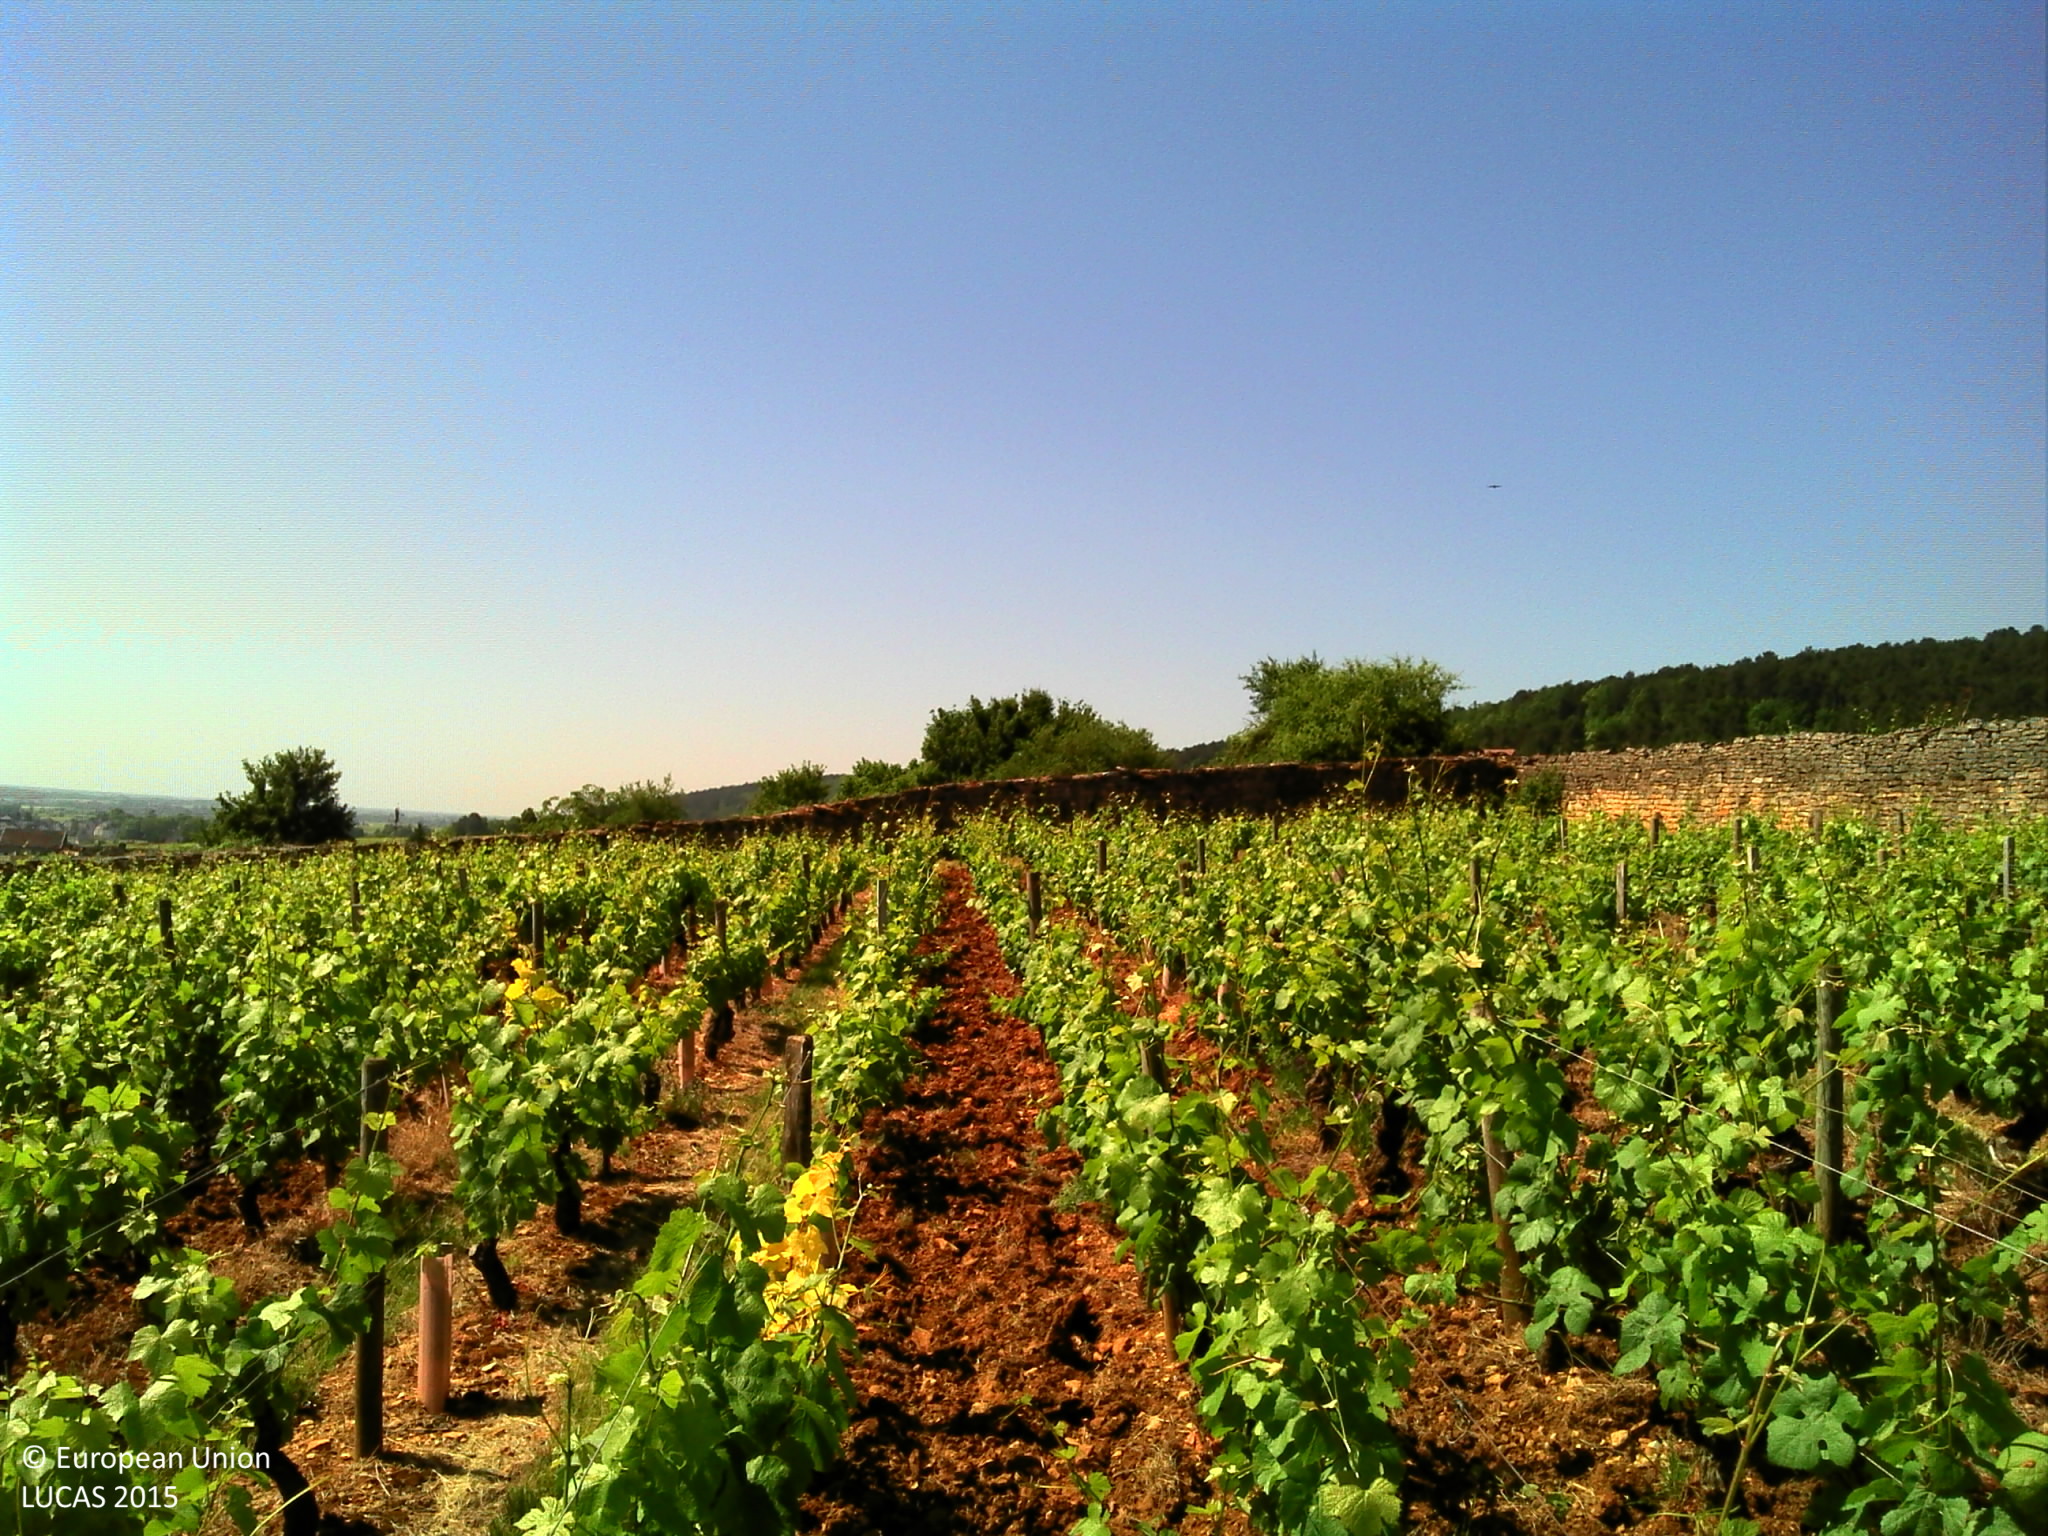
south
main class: Cropland
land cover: Vineyards
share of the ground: < 10 %
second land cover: Other bare soil
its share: > 75 %
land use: Agriculture (excluding fallow land and kitchen gardens)
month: June
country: FR
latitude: 47.2431
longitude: 4.9671
